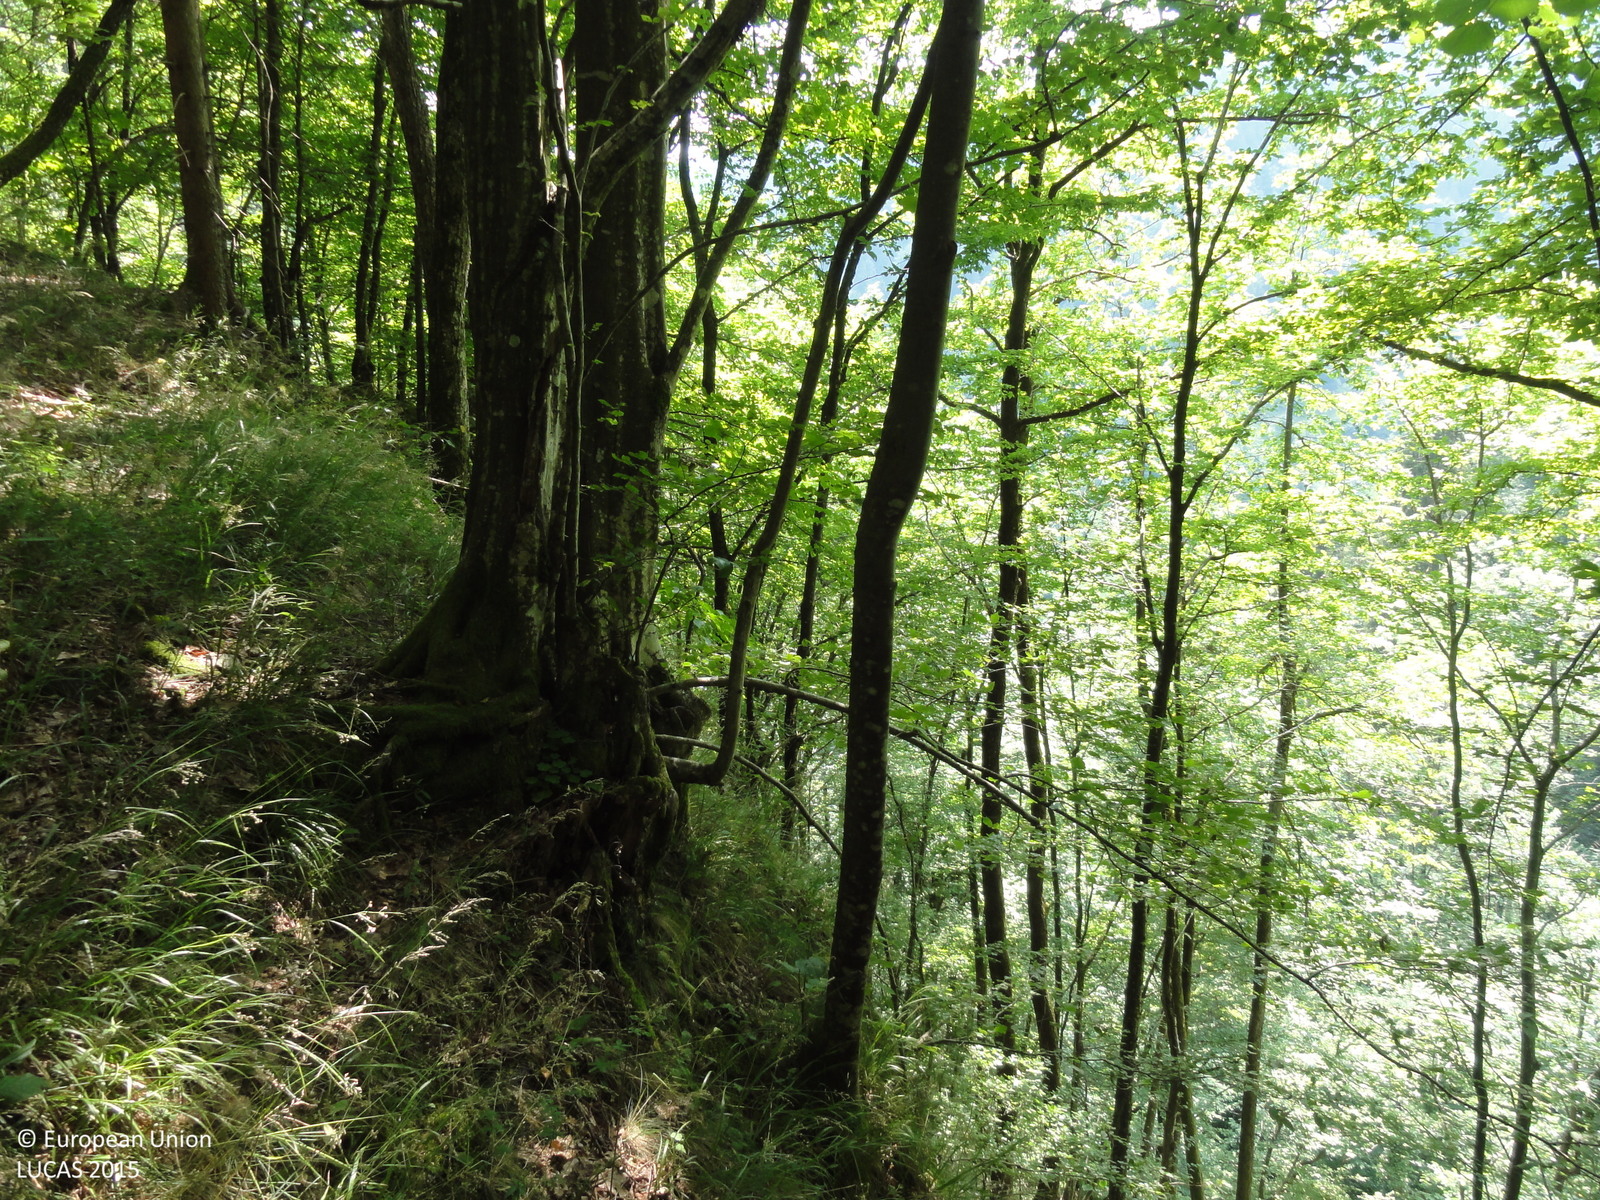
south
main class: Woodland
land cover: Spruce dominated mixed woodland
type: beech forest
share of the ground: > 75 %
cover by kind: broadleaved forest trees 75 %, coniferous forest trees 25 %
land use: Forestry
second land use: Amenities, museums, leisure
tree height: > 5 m
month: July
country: SI
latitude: 46.6431
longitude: 15.1327
